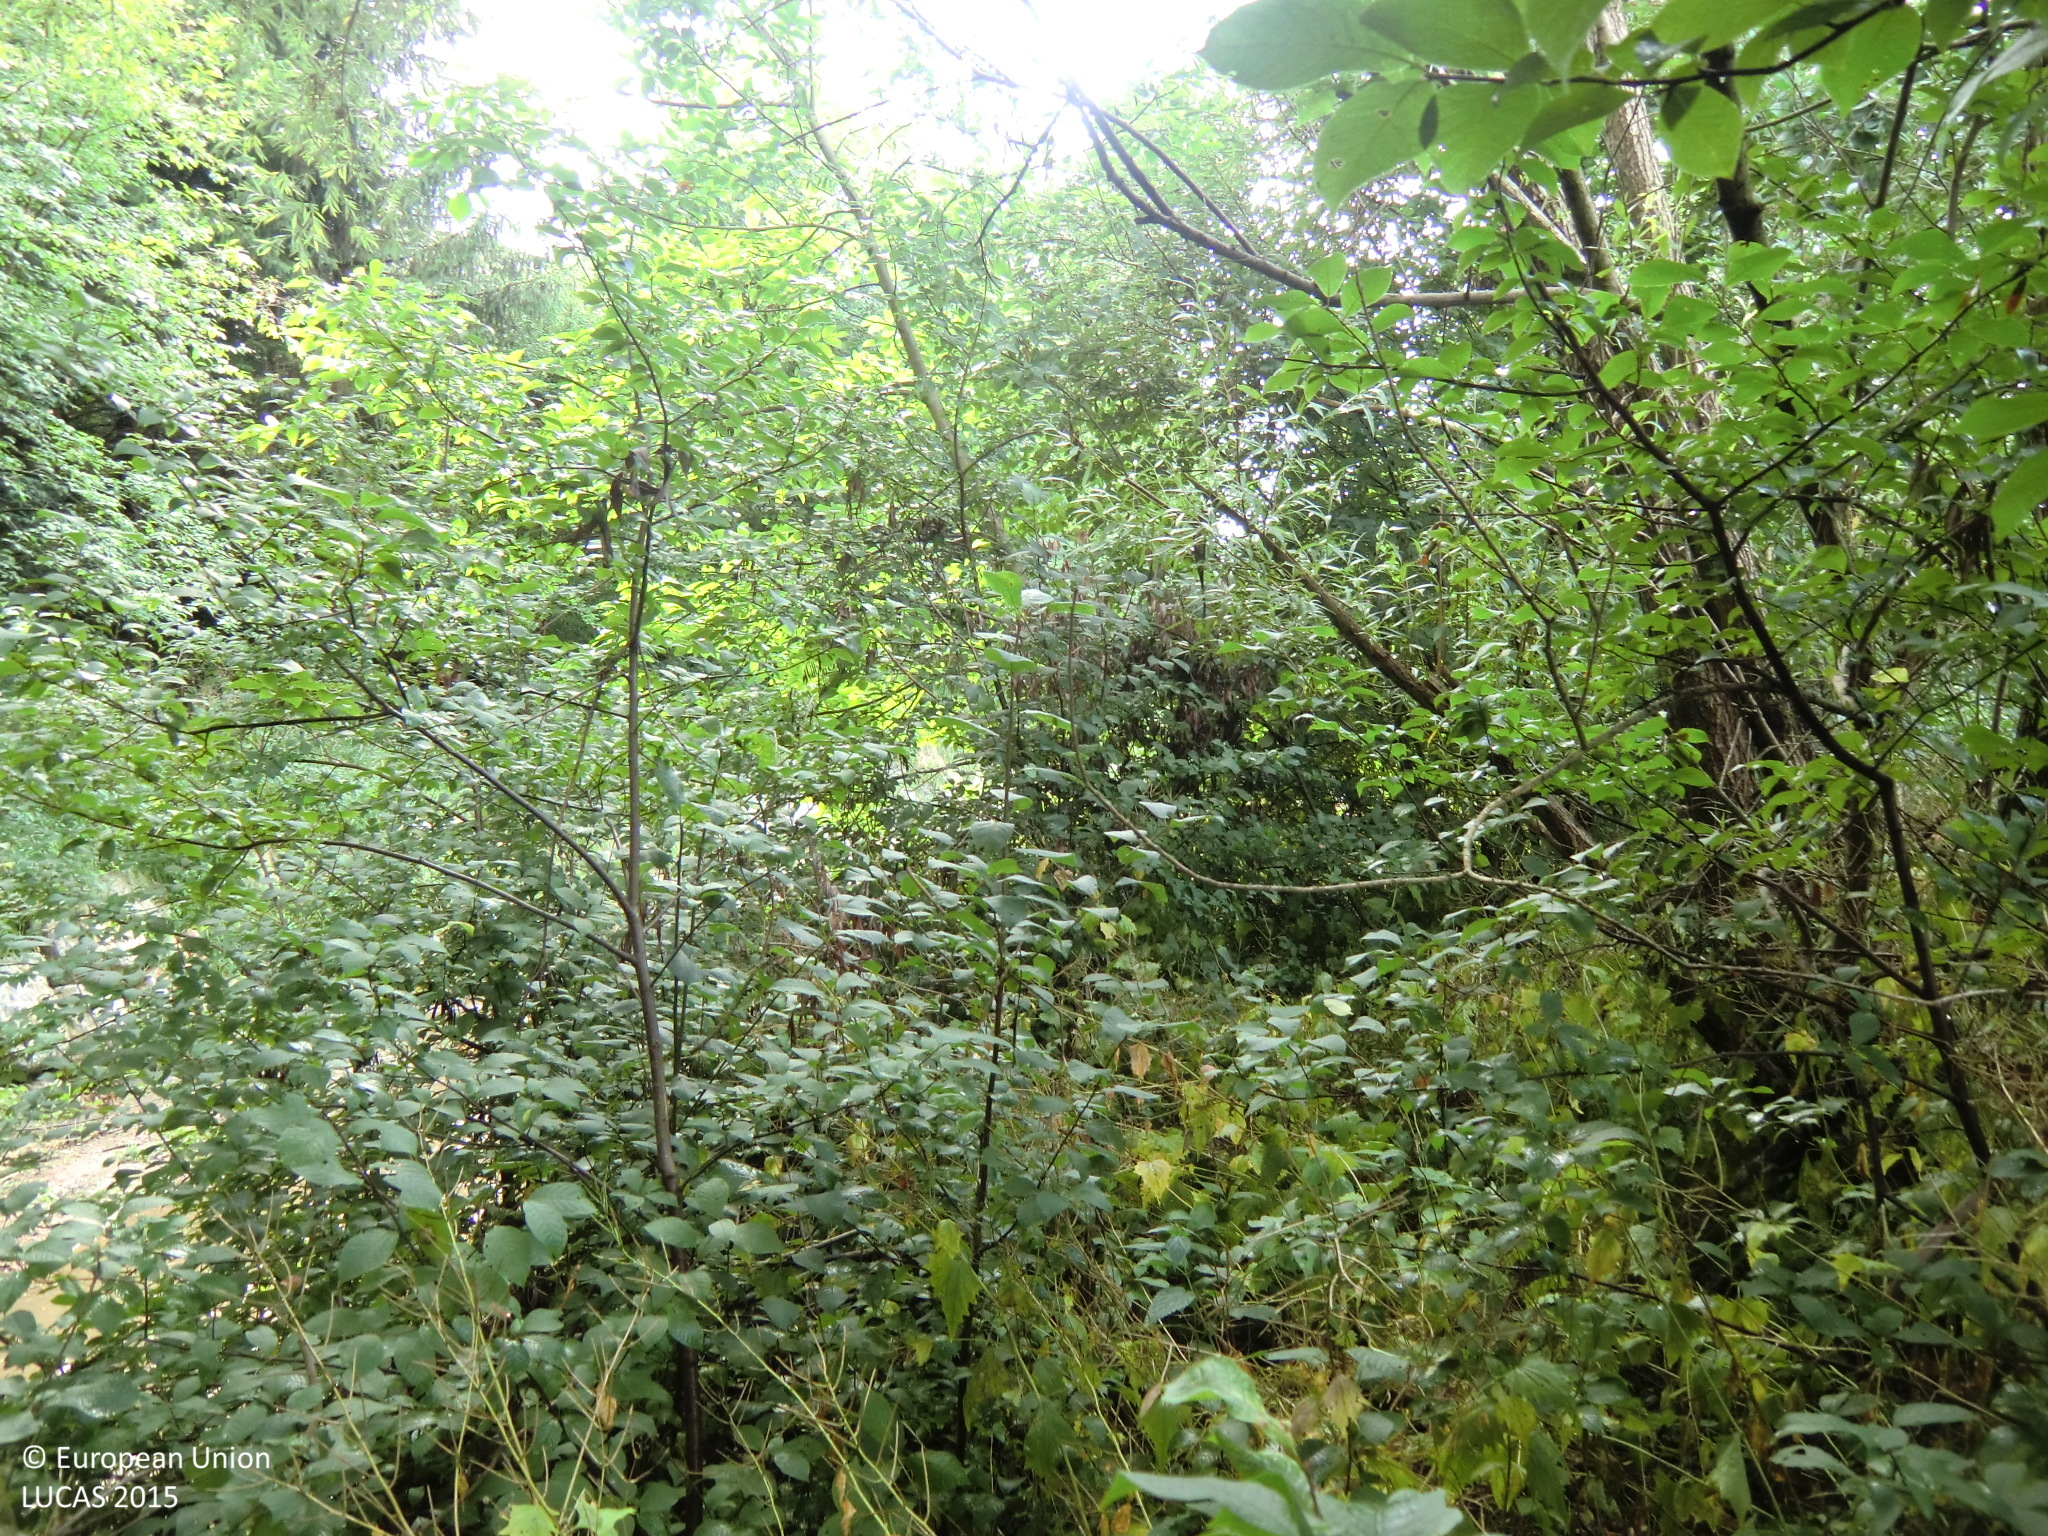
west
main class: Woodland
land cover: Broadleaved woodland
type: floodplain forest
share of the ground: > 75 %
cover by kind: broadleaved forest trees 90 %, herbaceous plants 10 %
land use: Semi-natural and natural areas not in use
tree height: > 5 m
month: July
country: AT
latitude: 47.0765
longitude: 15.4918
